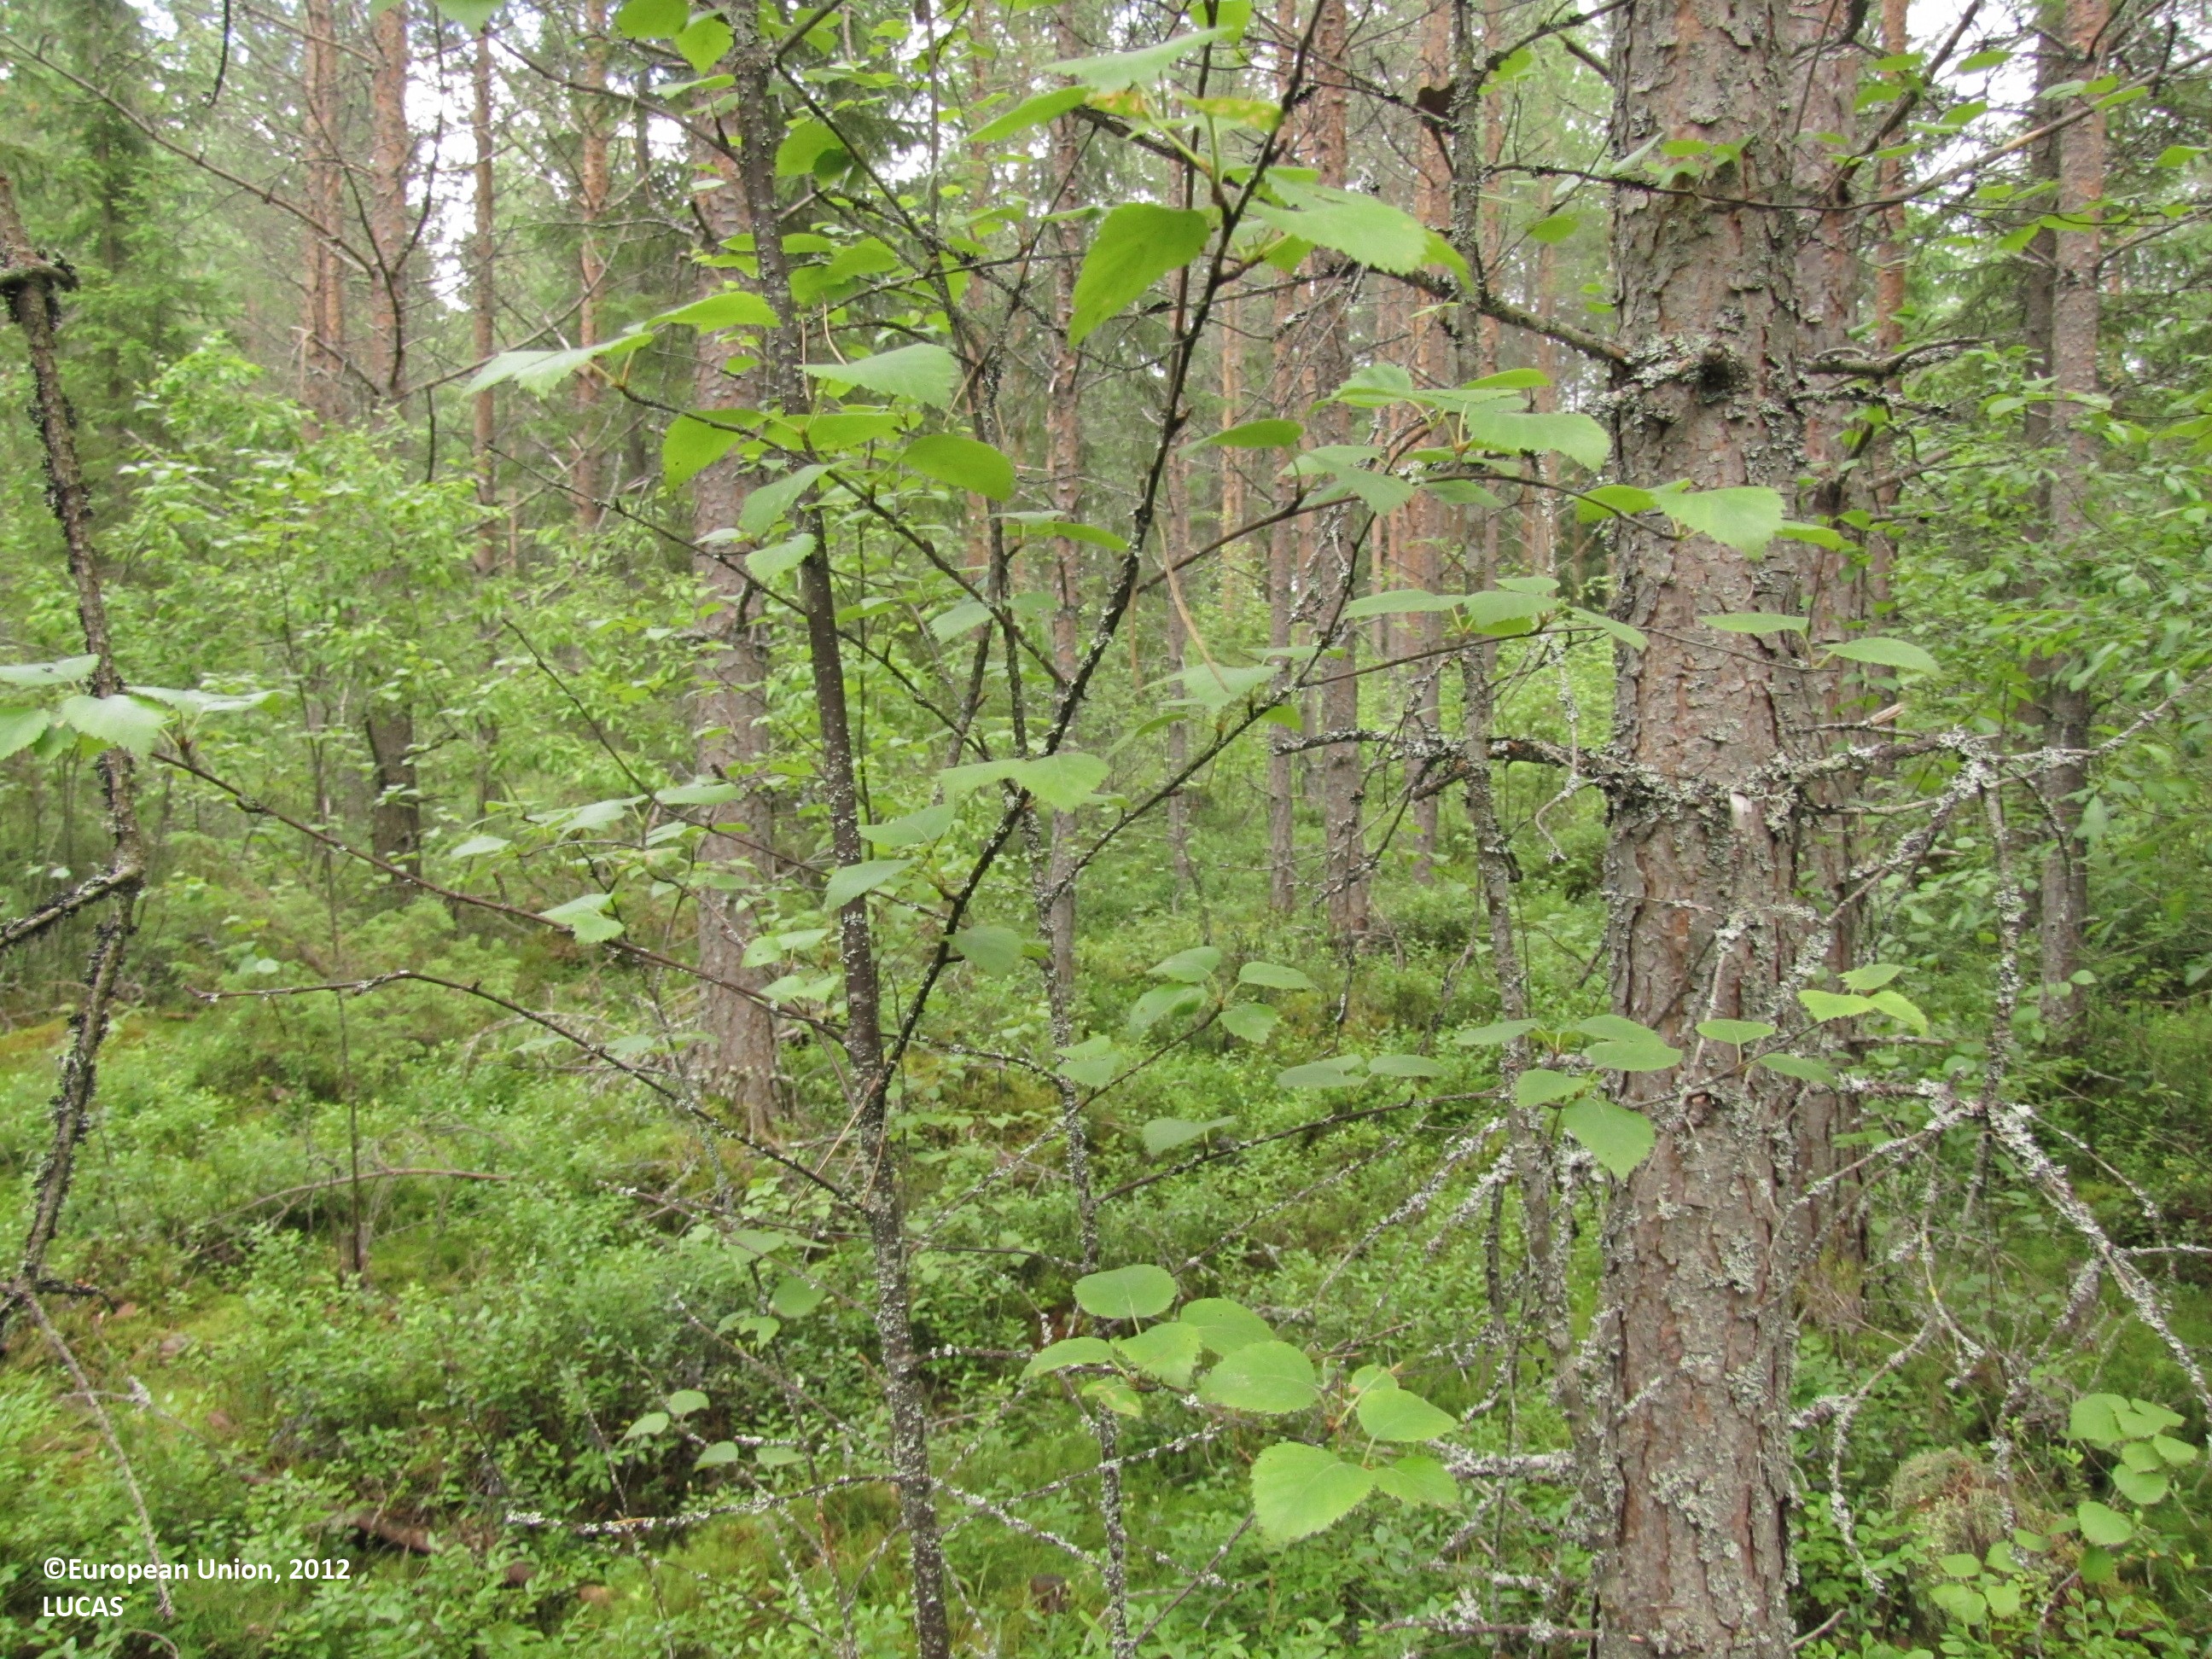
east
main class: Woodland
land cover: Pine dominated mixed woodland
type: boreal forest
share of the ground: > 75 %
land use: Forestry
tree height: > 5 m
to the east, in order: Pine dominated mixed woodland; Spruce dominated mixed woodland; Abandoned hedges; Ditches and canals; Temporary grasslands; Broadleaved woodland; Grassland with sparse tree/shrub cover; Artificial constructions in urban areas; Shrubland with sparse tree cover; Grassland with sparse tree/shrub cover; Barley
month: July
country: FI
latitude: 62.5048
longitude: 24.0010
